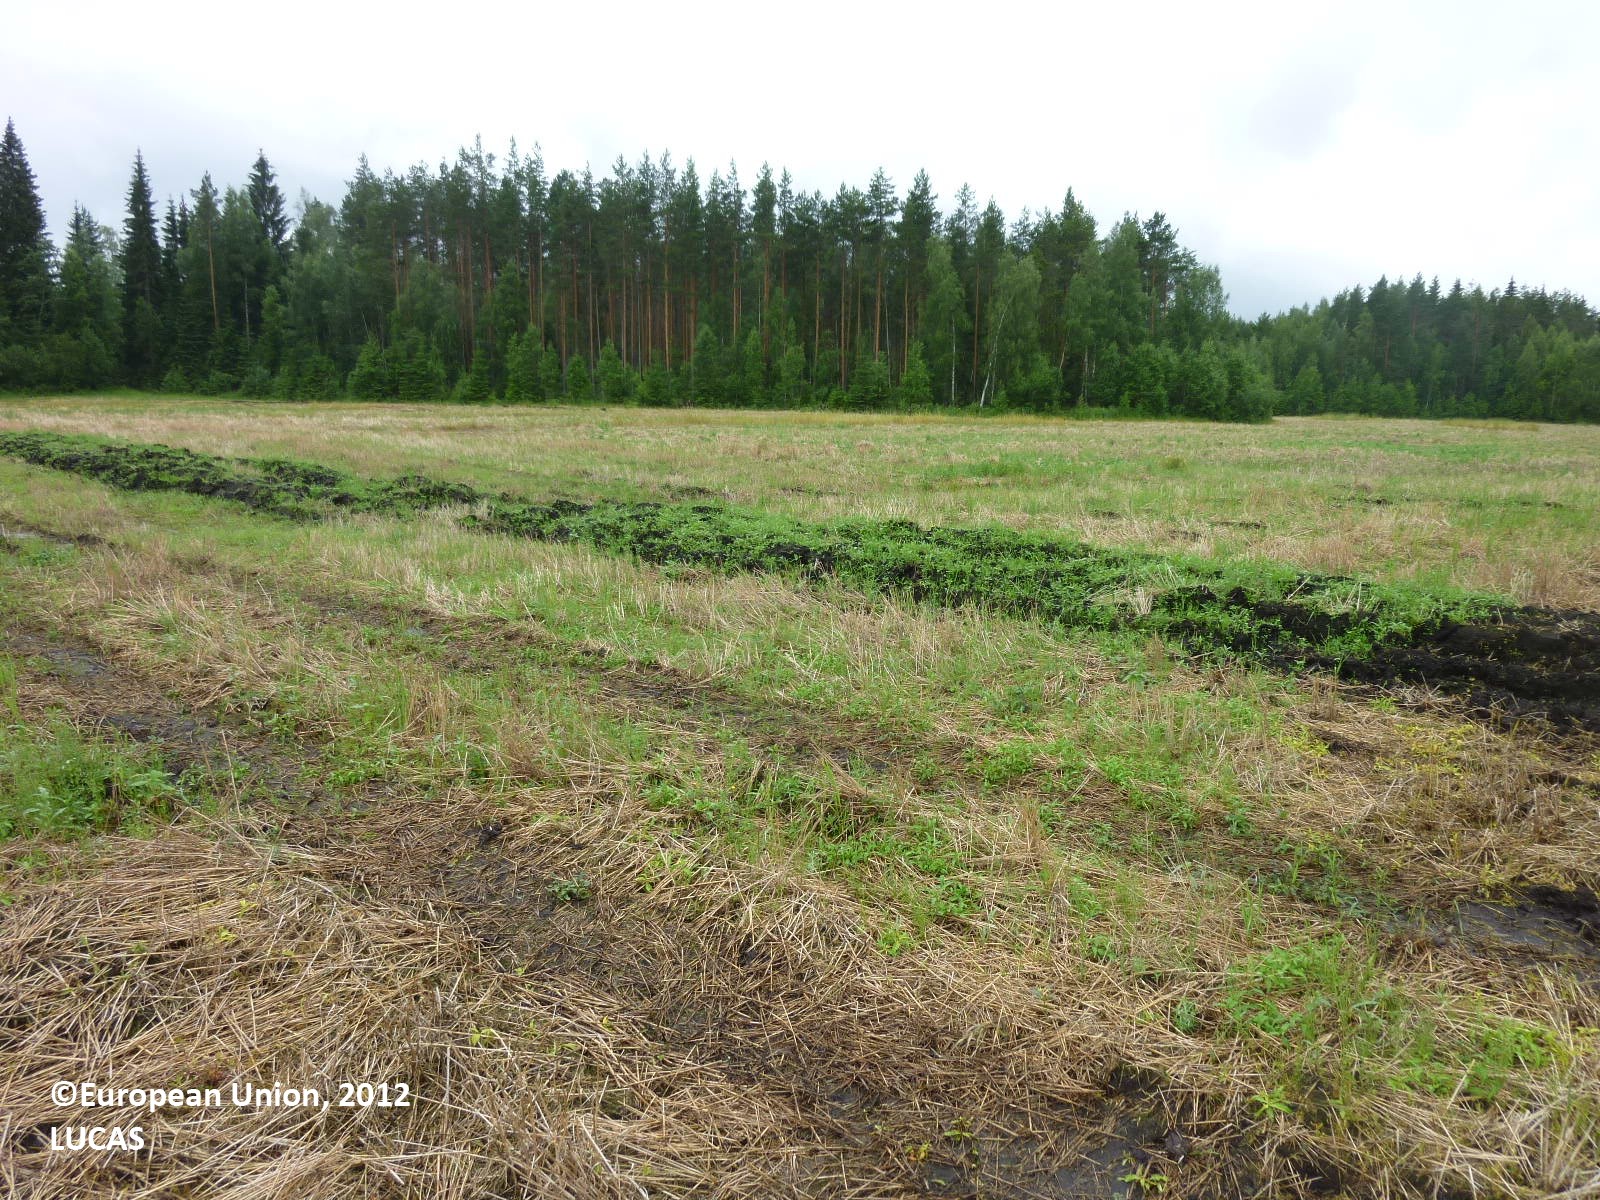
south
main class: Cropland
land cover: Oats
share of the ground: > 75 %
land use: Agriculture (excluding fallow land and kitchen gardens)
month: July
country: FI
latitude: 61.4651
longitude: 22.7340
